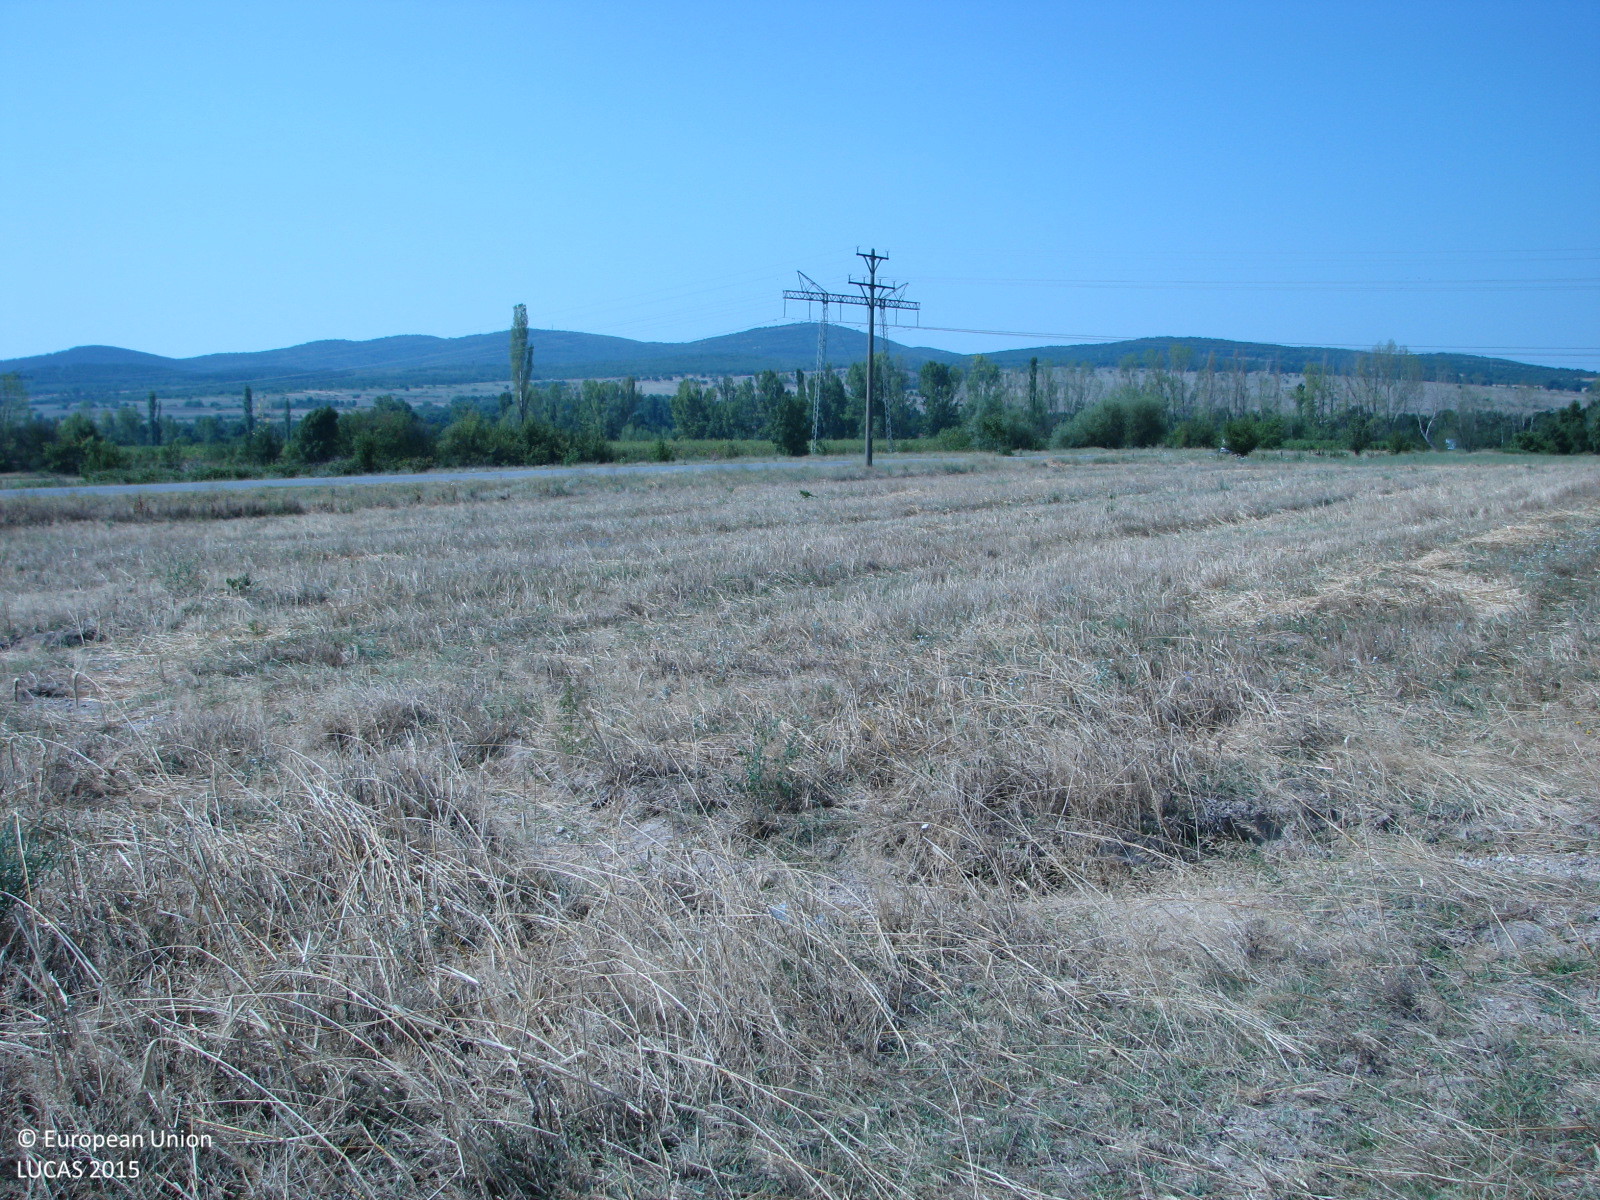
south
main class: Cropland
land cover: Rye
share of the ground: > 75 %
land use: Agriculture (excluding fallow land and kitchen gardens)
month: July
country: BG
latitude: 42.6657
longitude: 25.9551
